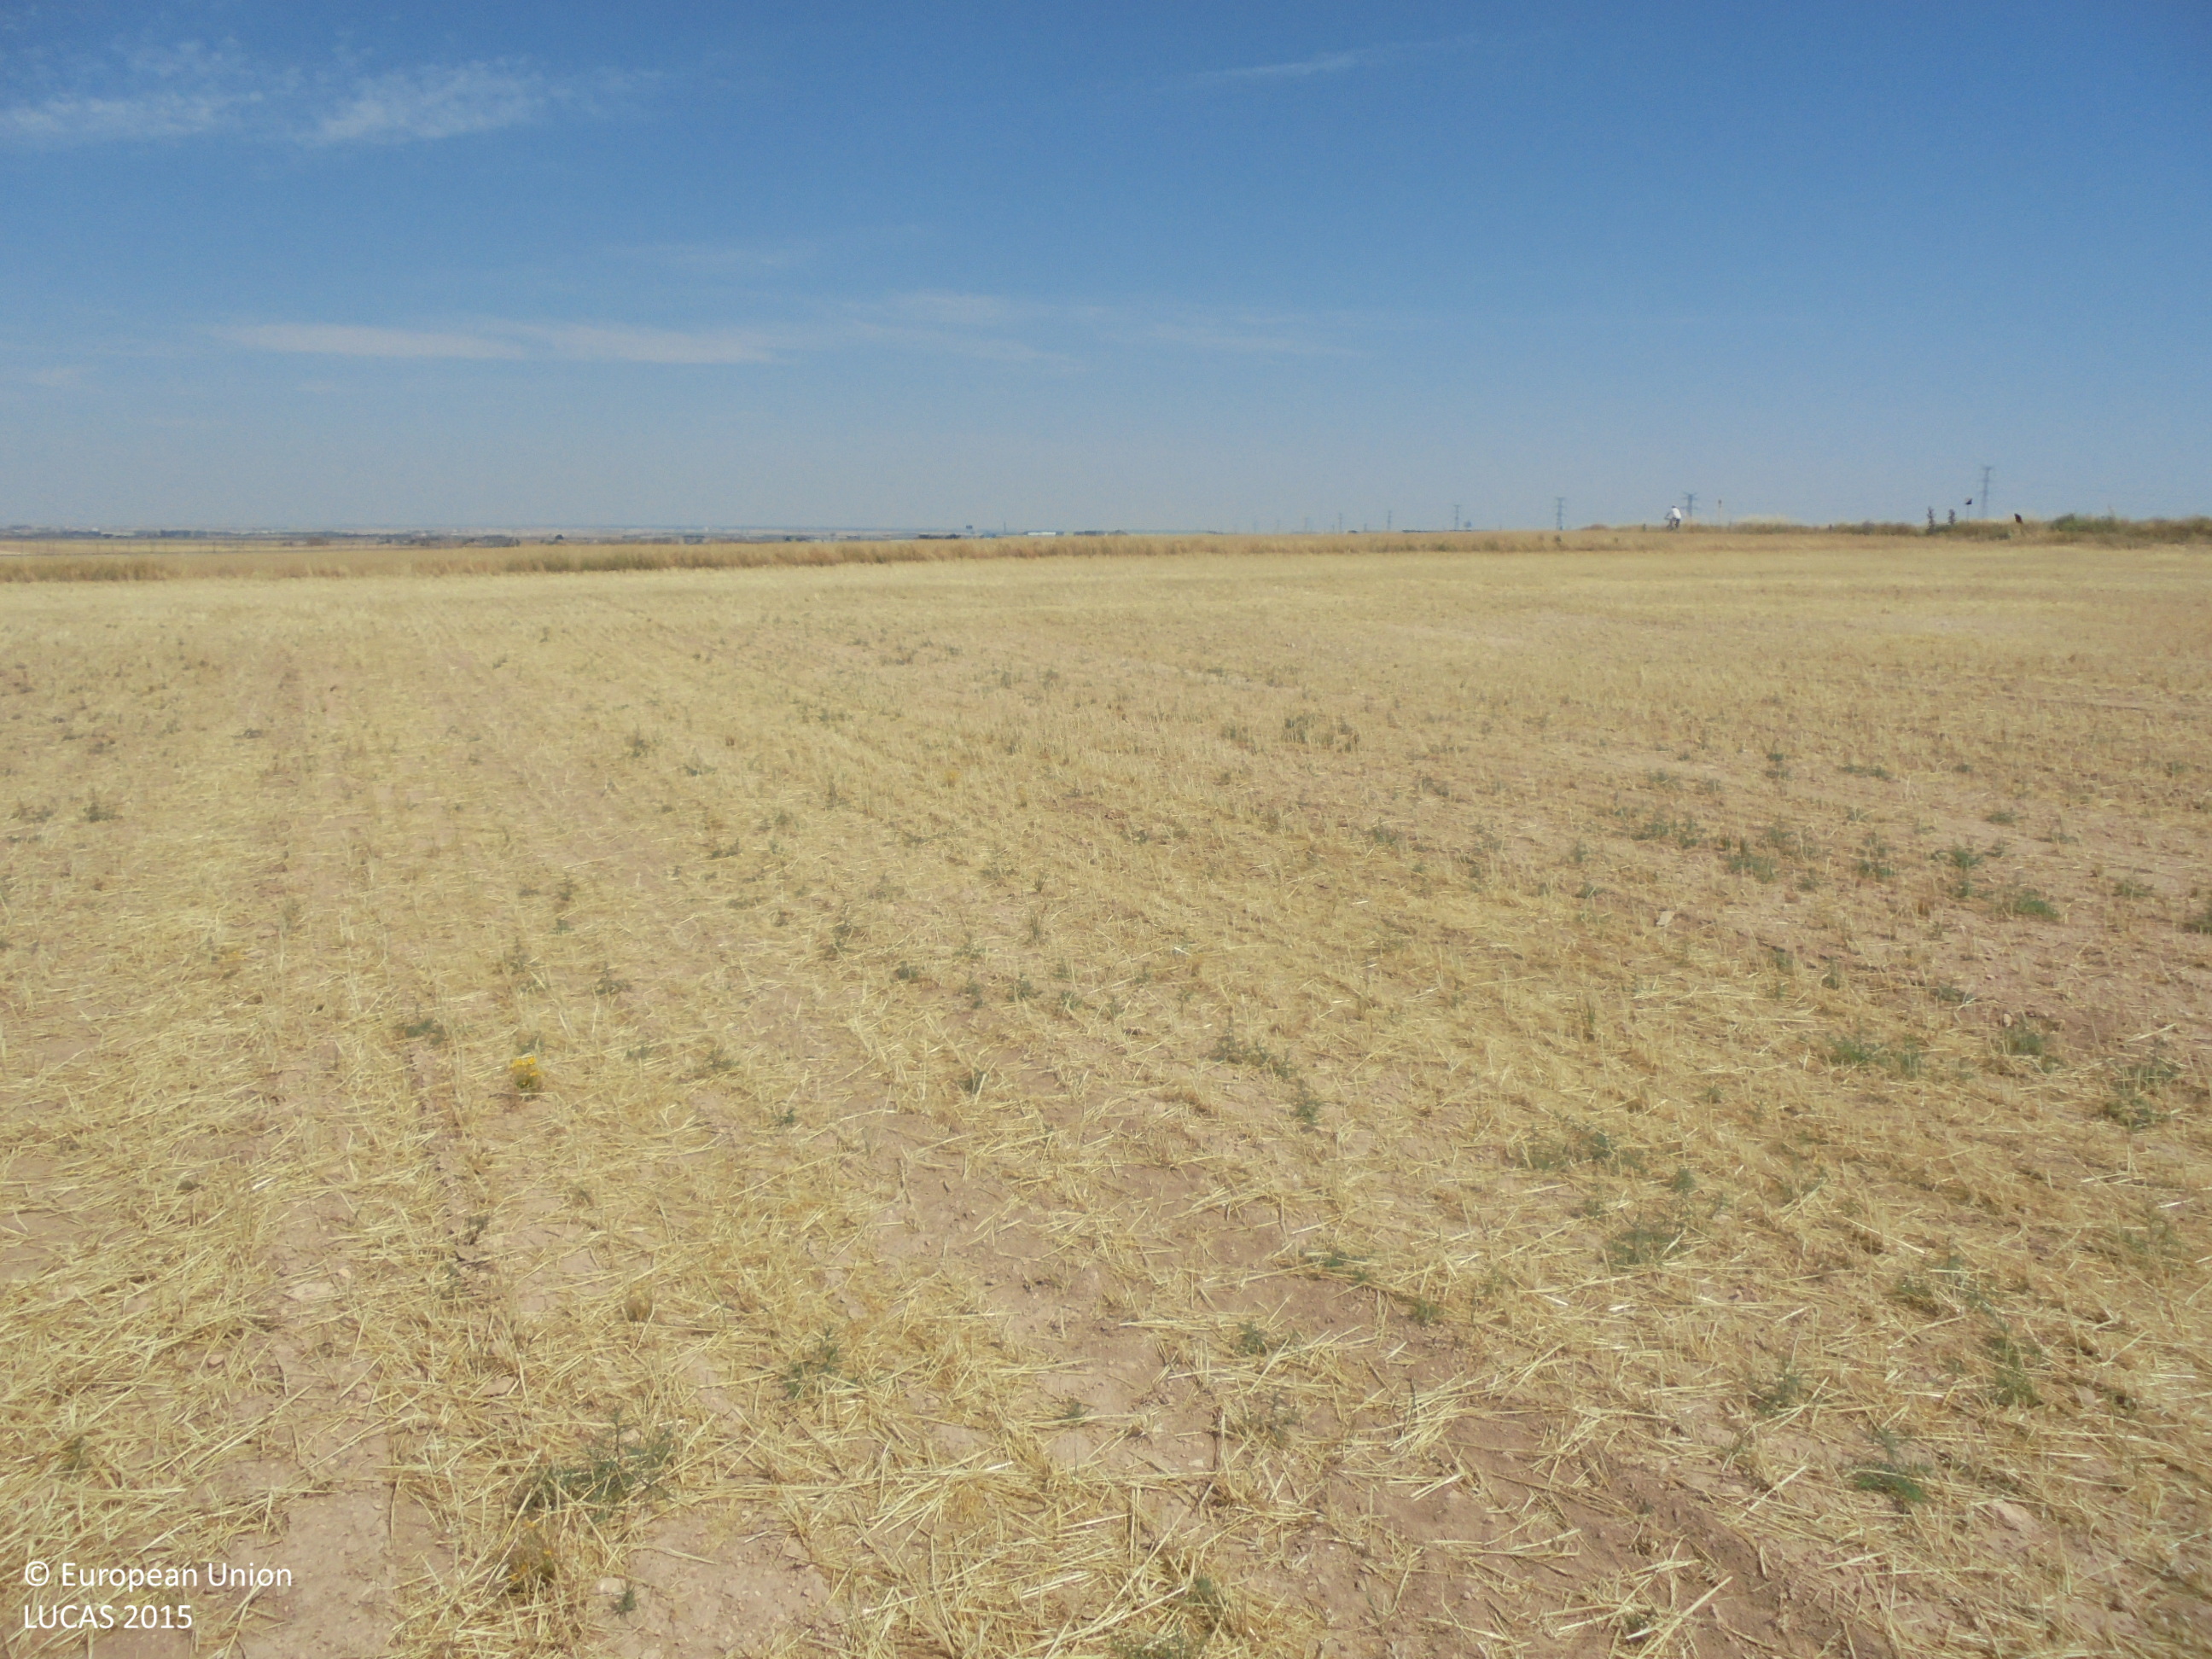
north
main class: Cropland
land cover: Barley
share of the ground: < 10 %
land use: Agriculture (excluding fallow land and kitchen gardens)
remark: Harvested field
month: June
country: ES
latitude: 38.9189
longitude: -1.7514
